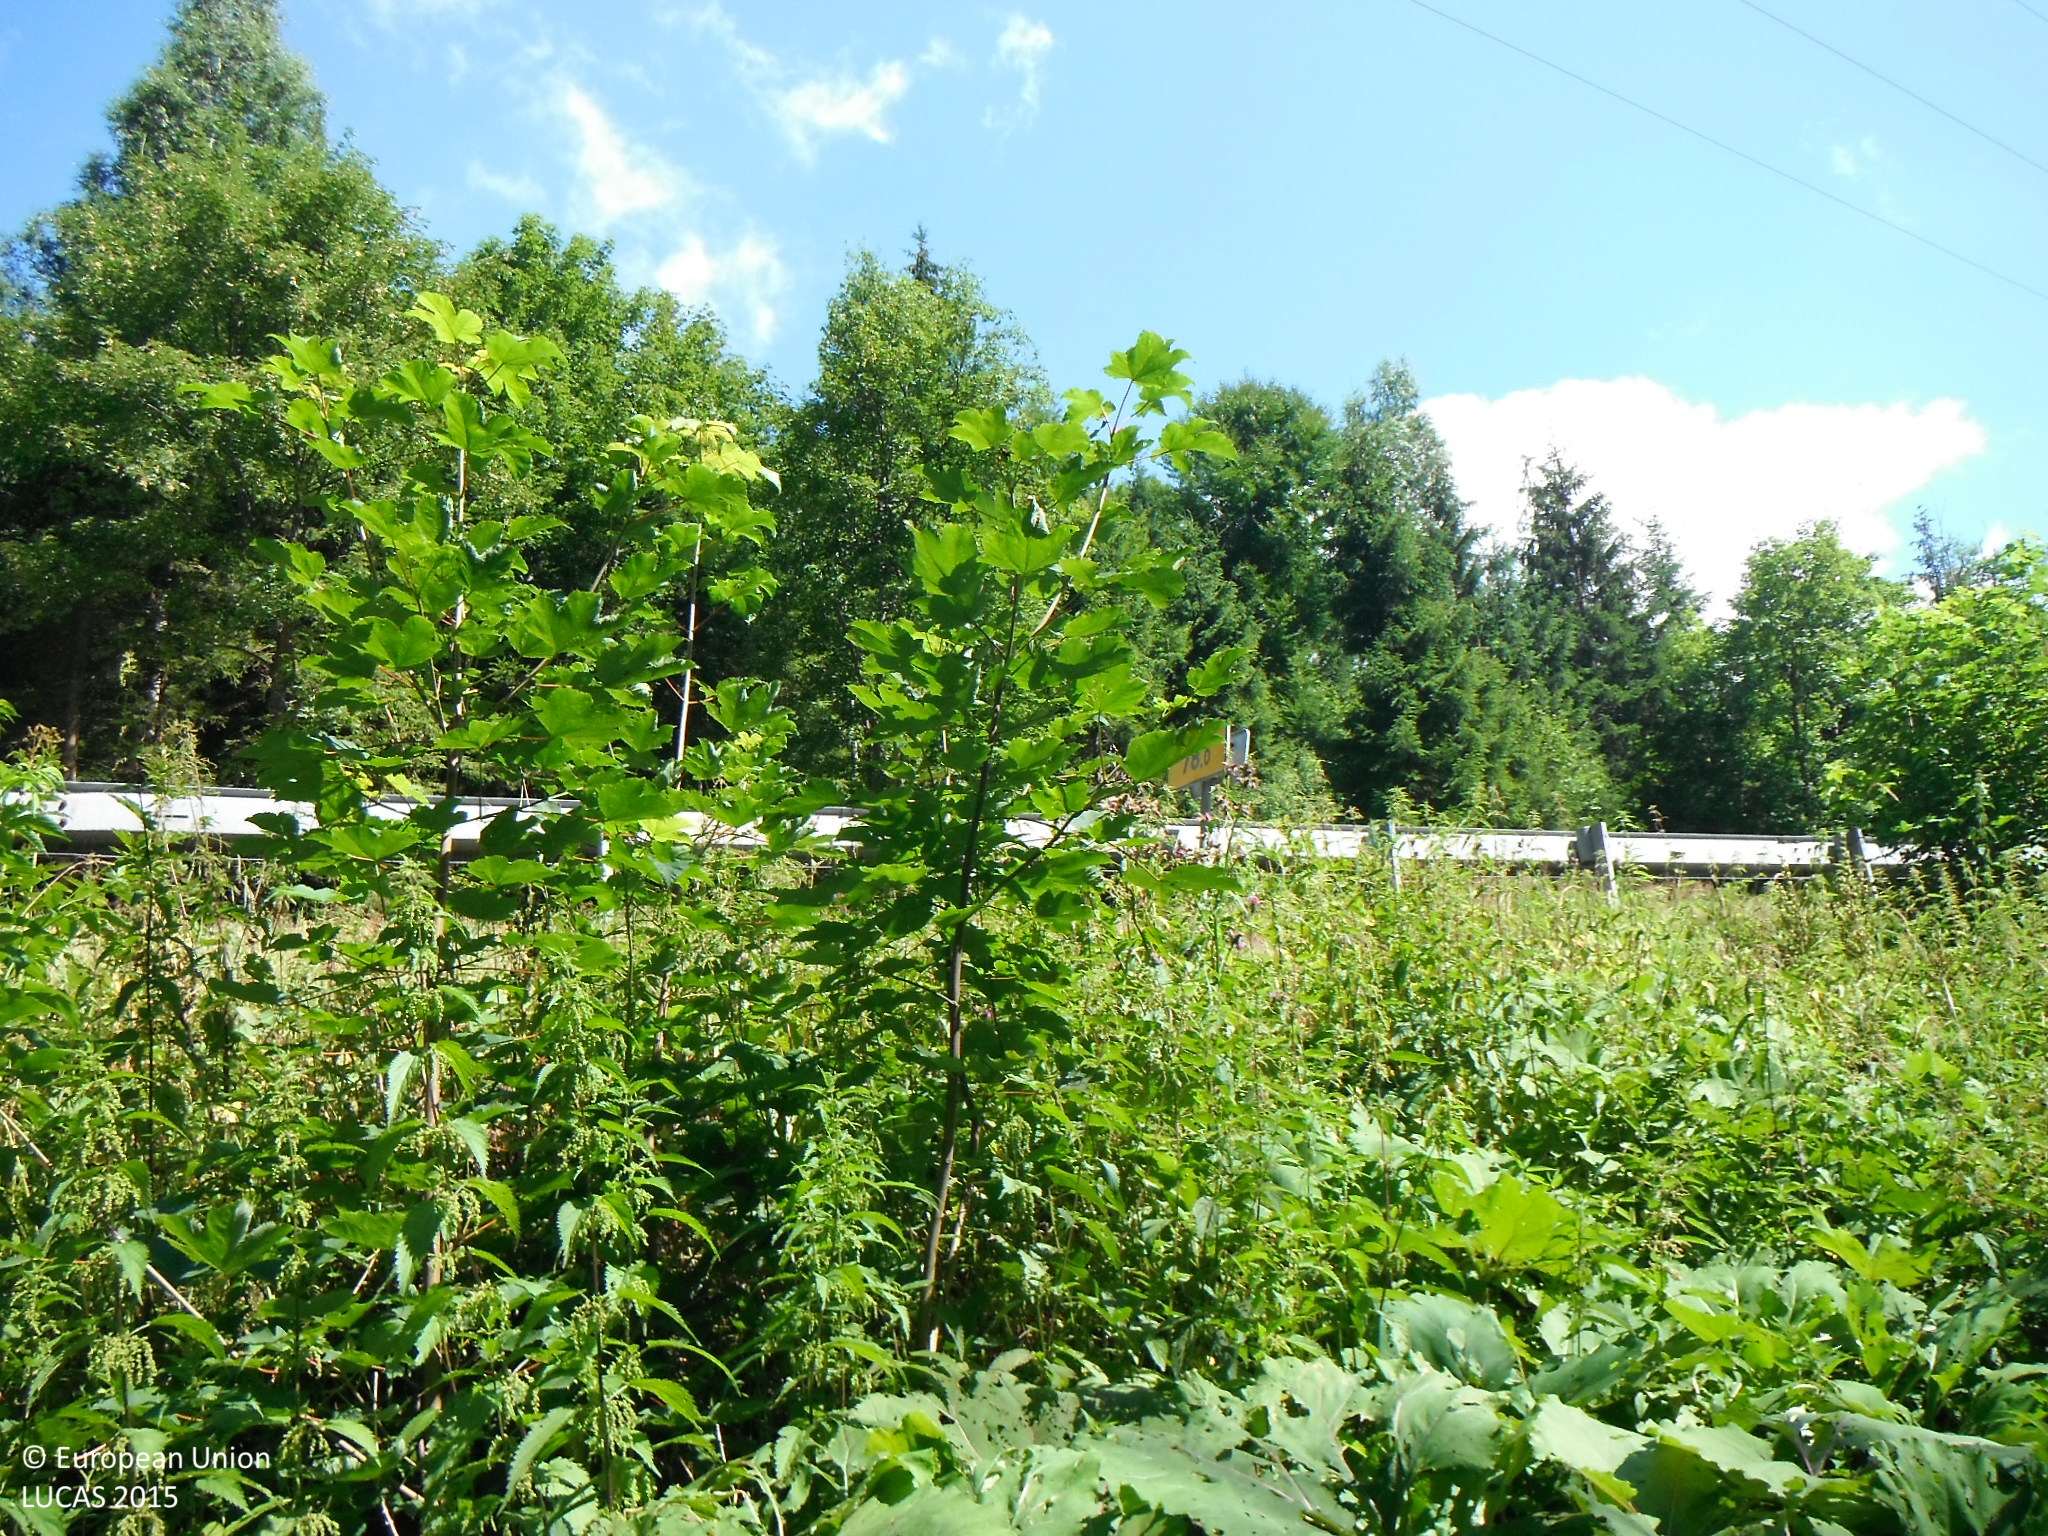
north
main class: Woodland
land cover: Spruce dominated mixed woodland
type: mountainous beech forest
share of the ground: > 75 %
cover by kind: broadleaved forest trees 50 %, coniferous forest trees 25 %, shrubs 15 %, herbaceous plants 10 %
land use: Forestry
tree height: > 5 m
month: July
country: SK
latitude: 48.8848
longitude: 19.6689
